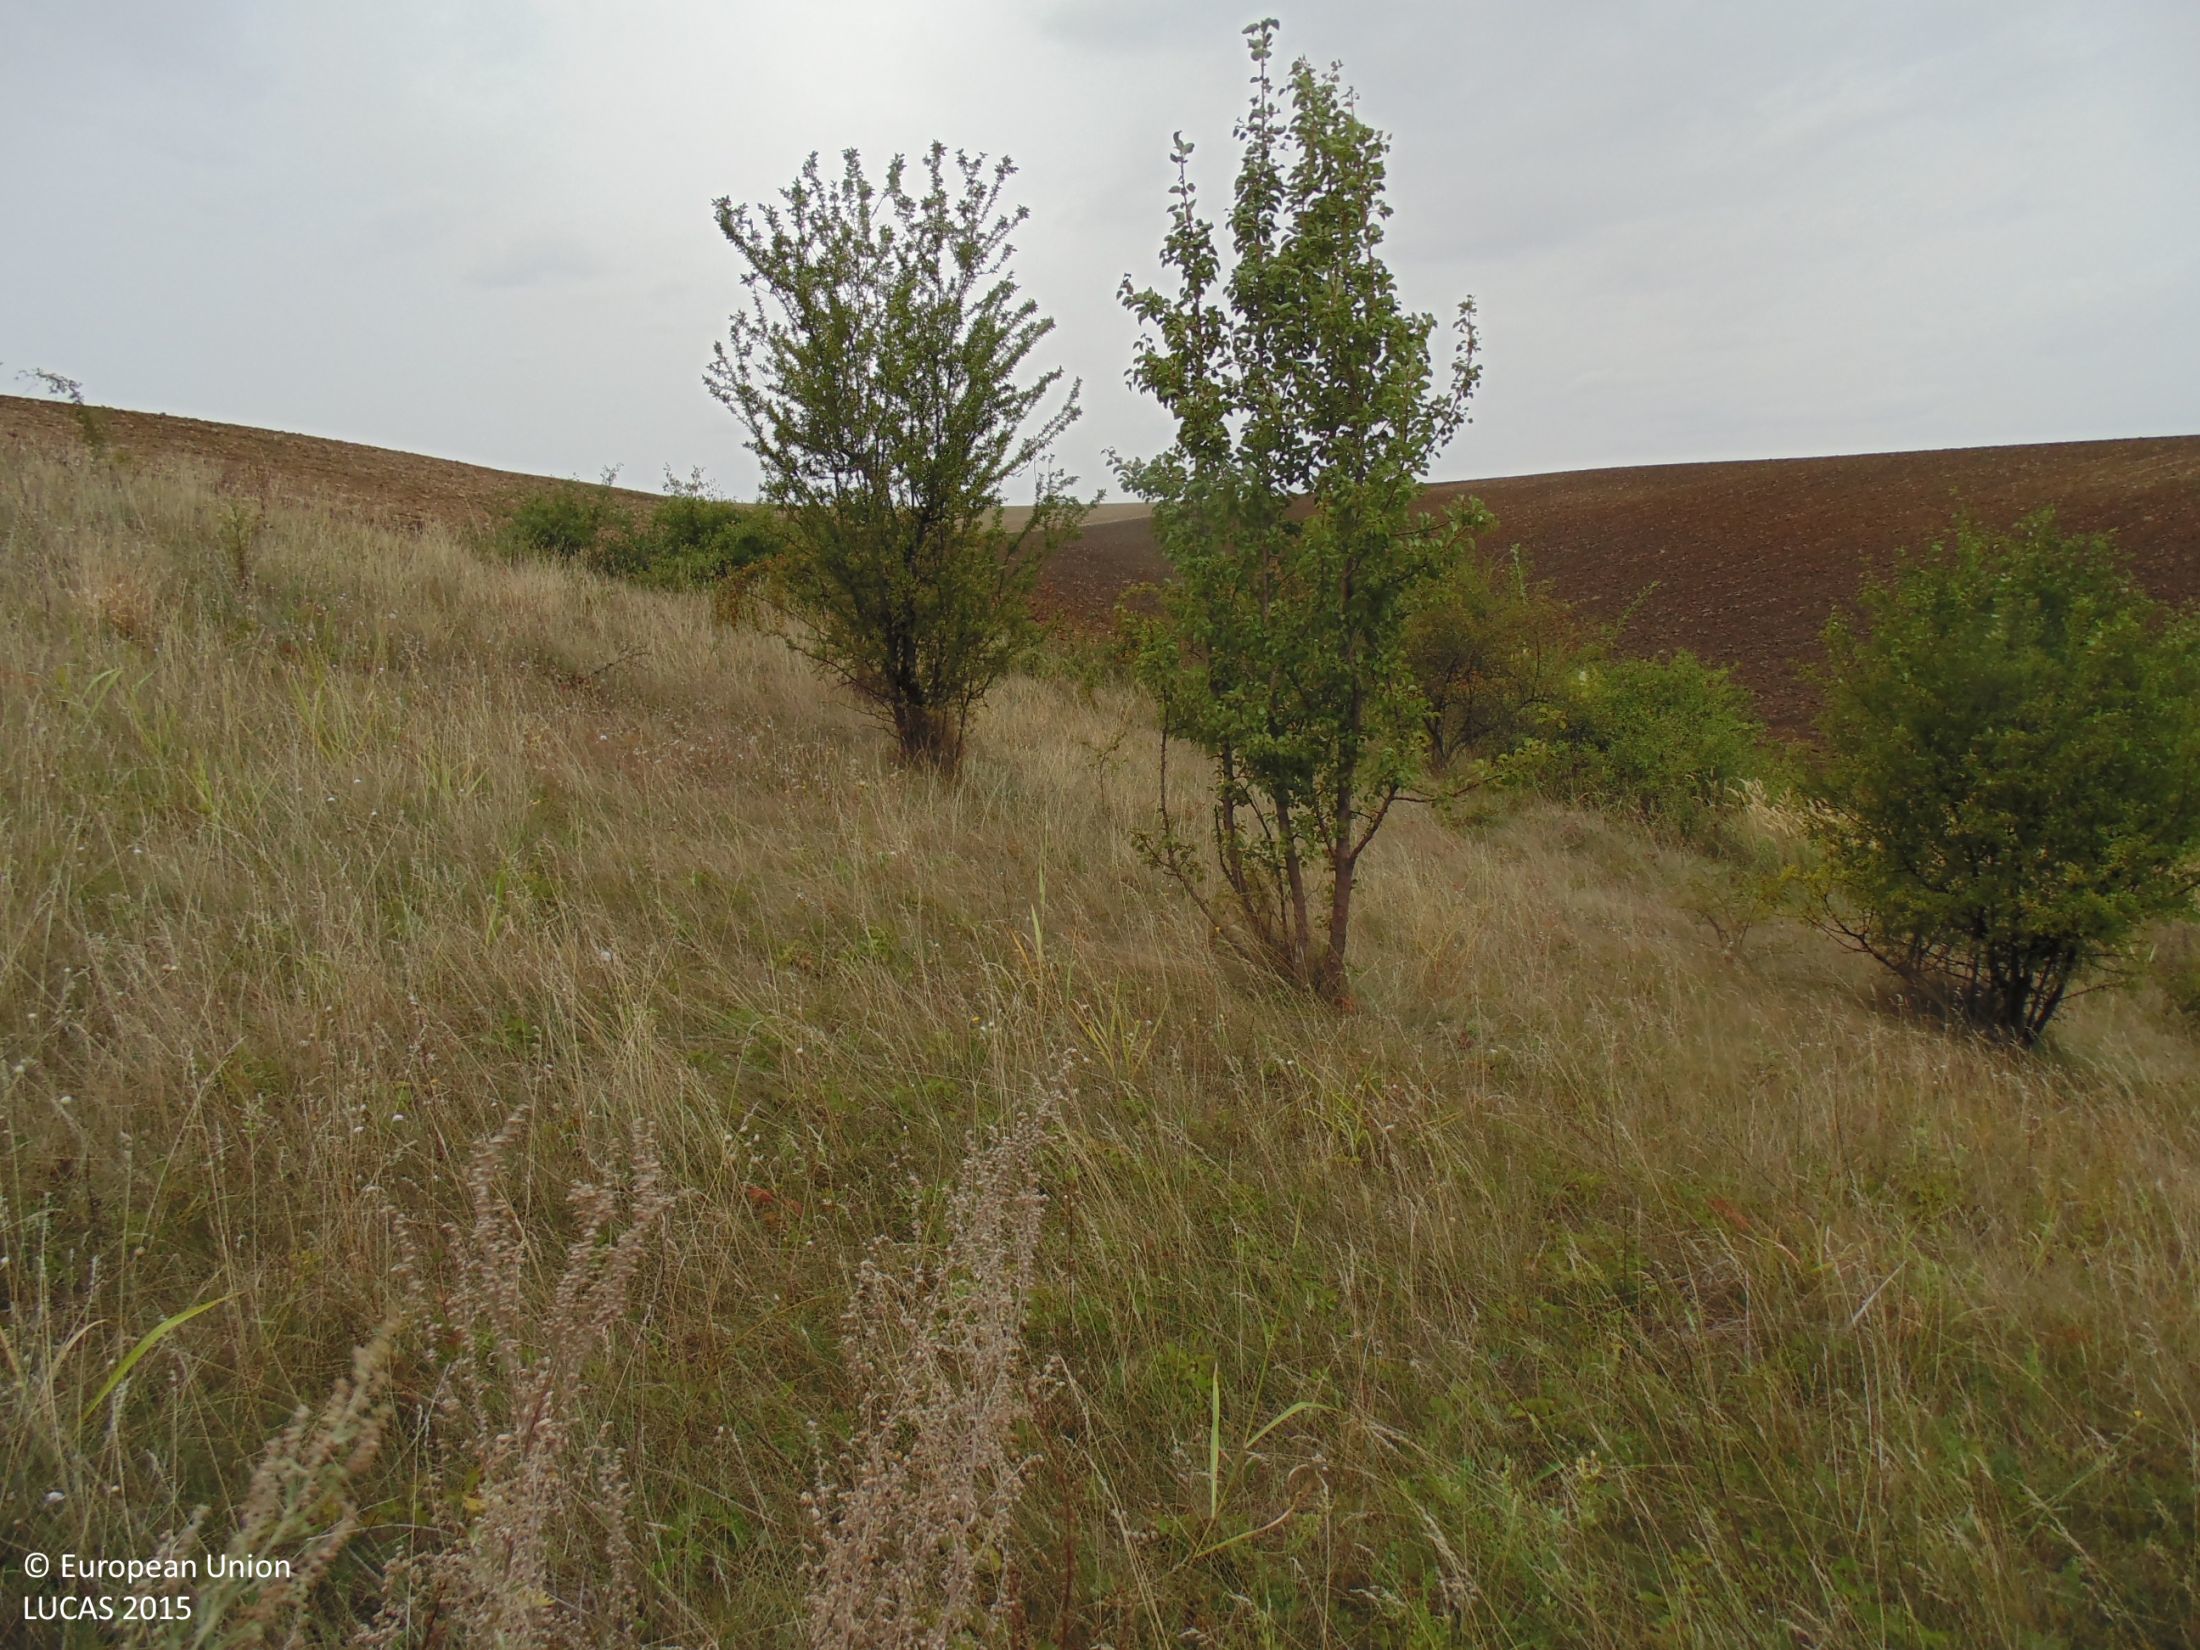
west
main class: Grassland
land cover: Grassland with sparse tree/shrub cover
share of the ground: > 75 %
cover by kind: herbaceous plants 85 %, shrubs 10 %, broadleaved forest trees 5 %
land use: Semi-natural and natural areas not in use
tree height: < 5 m
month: September
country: BG
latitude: 43.9976
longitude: 26.9187
